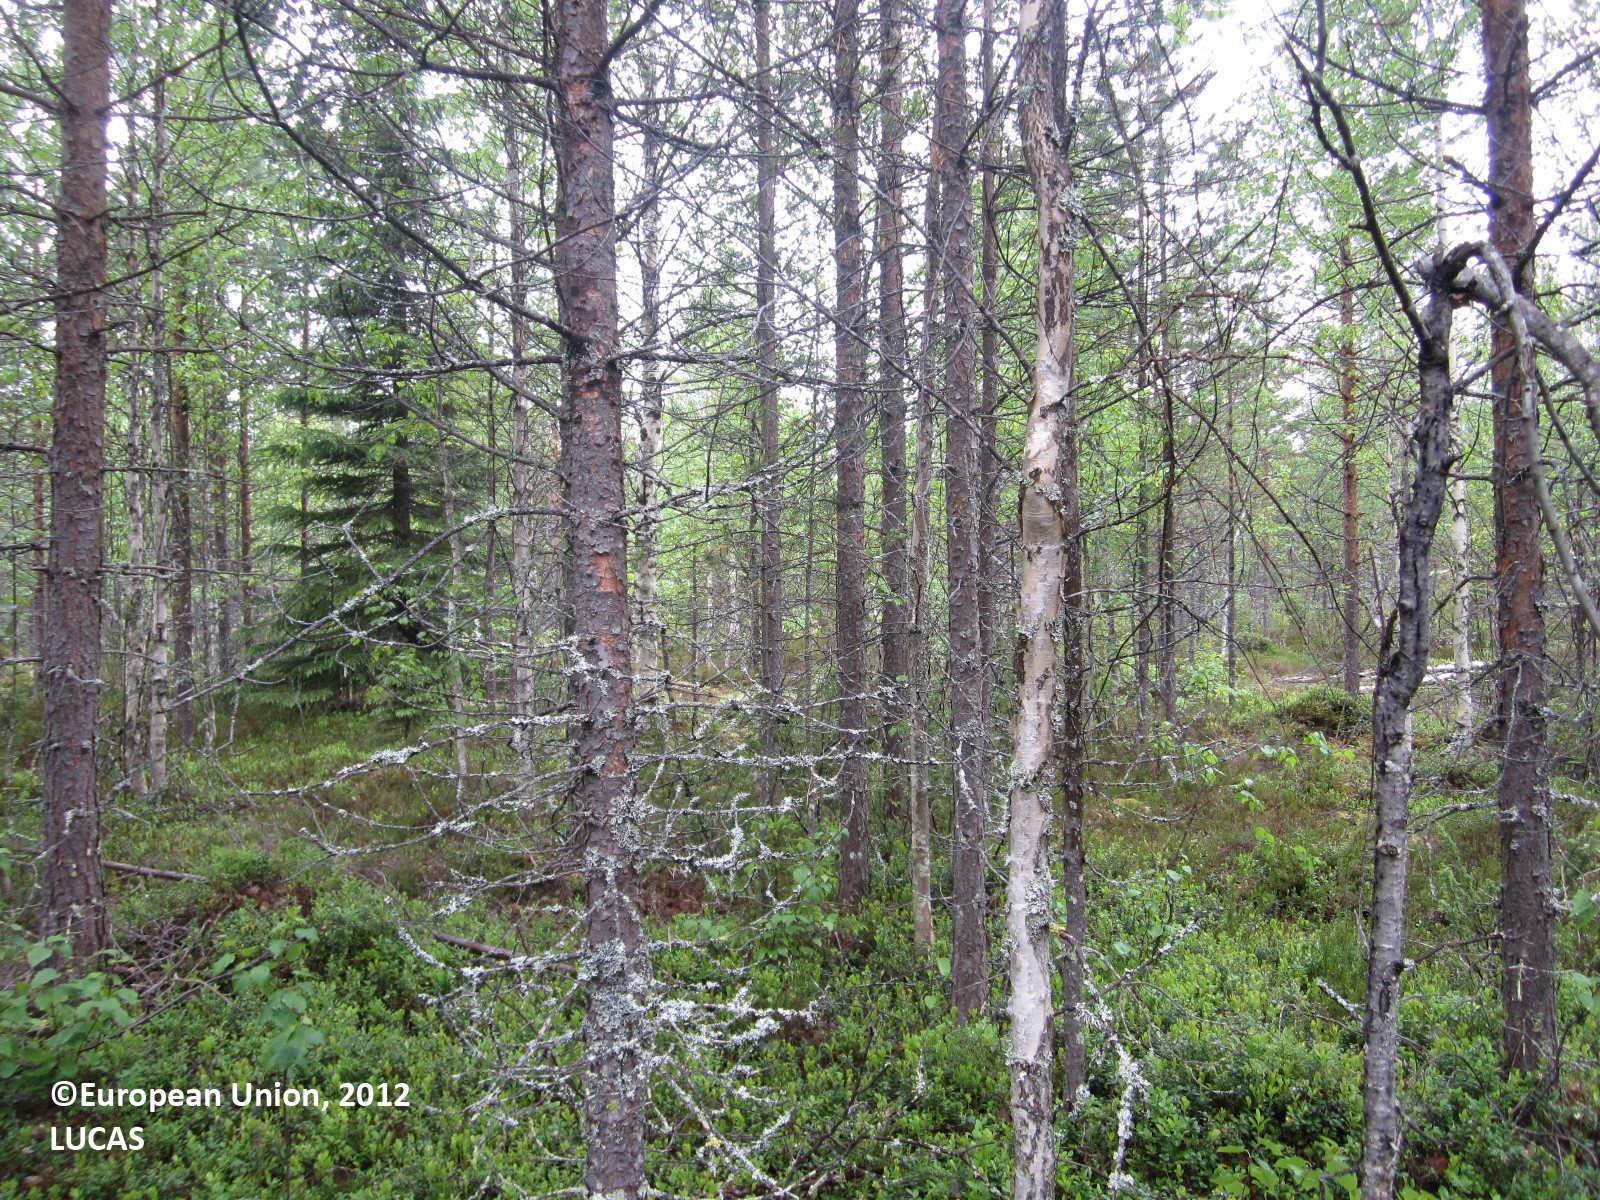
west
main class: Woodland
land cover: Pine dominated mixed woodland
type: boreal forest
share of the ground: 50 - 75 %
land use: Forestry
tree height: > 5 m
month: June
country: FI
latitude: 64.4335
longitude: 29.1193
